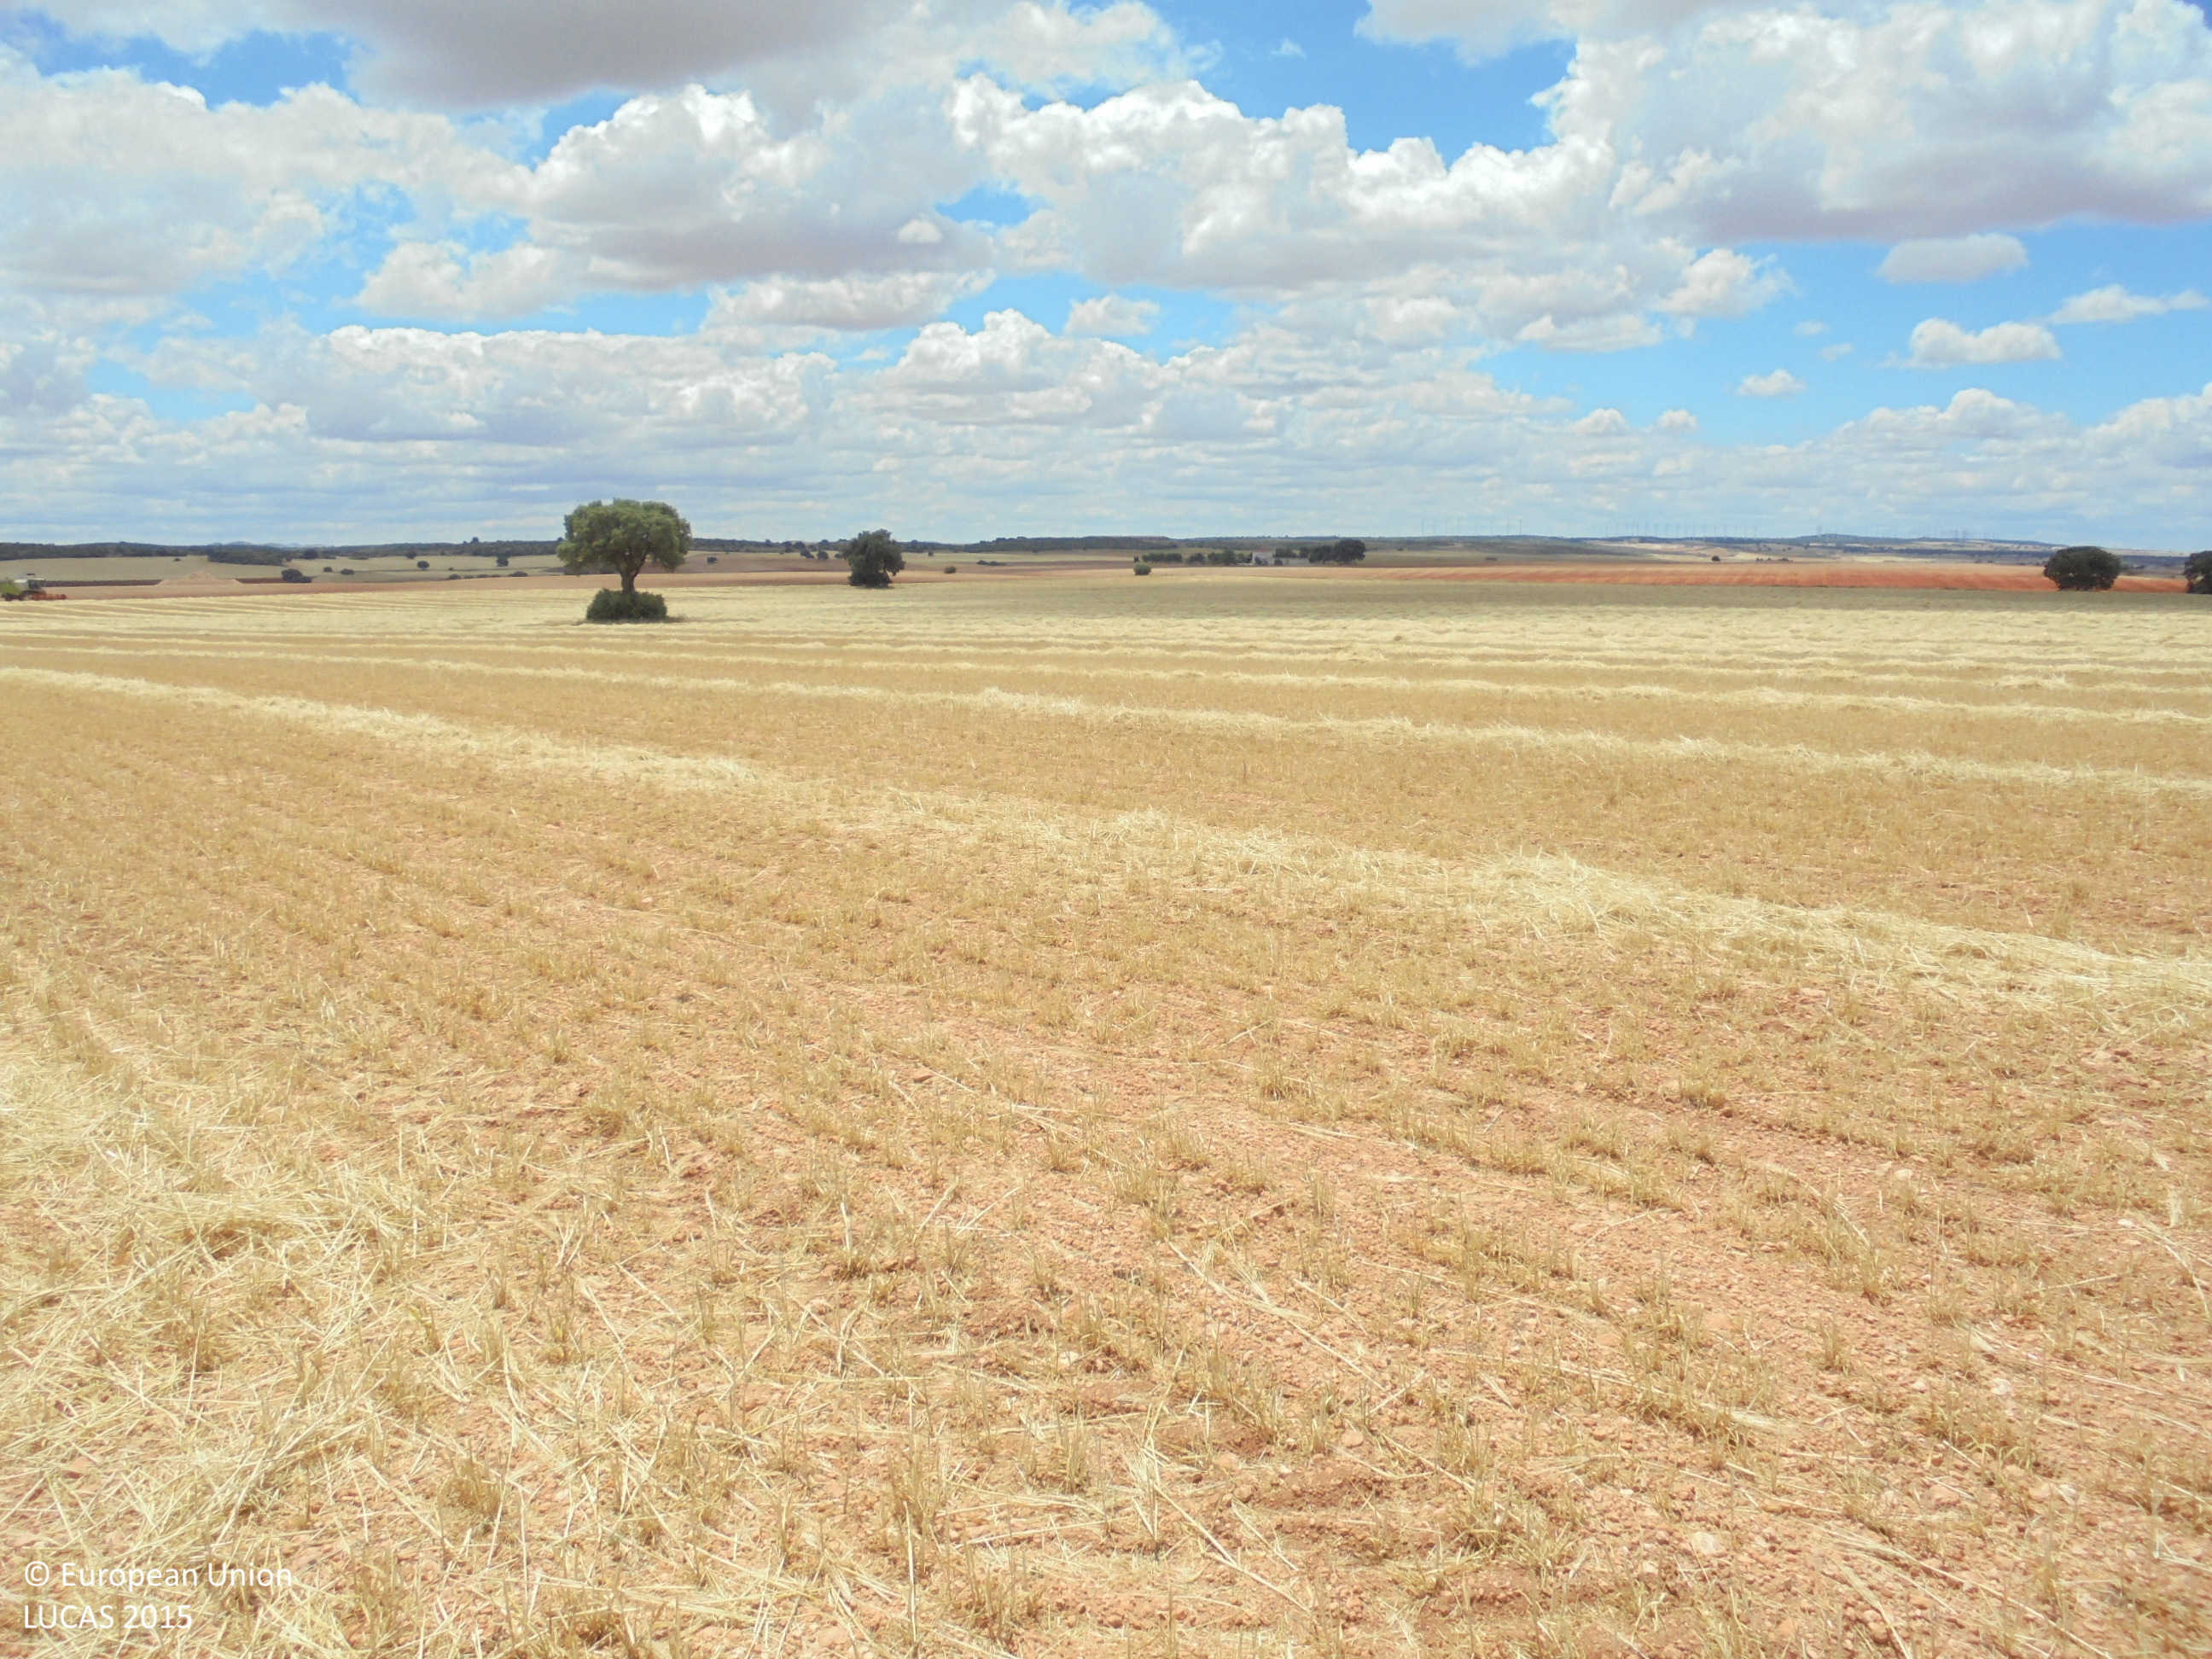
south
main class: Cropland
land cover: Barley
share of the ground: 50 - 75 %
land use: Agriculture (excluding fallow land and kitchen gardens)
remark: Harvested field
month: June
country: ES
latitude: 38.8652
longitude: -1.4403
